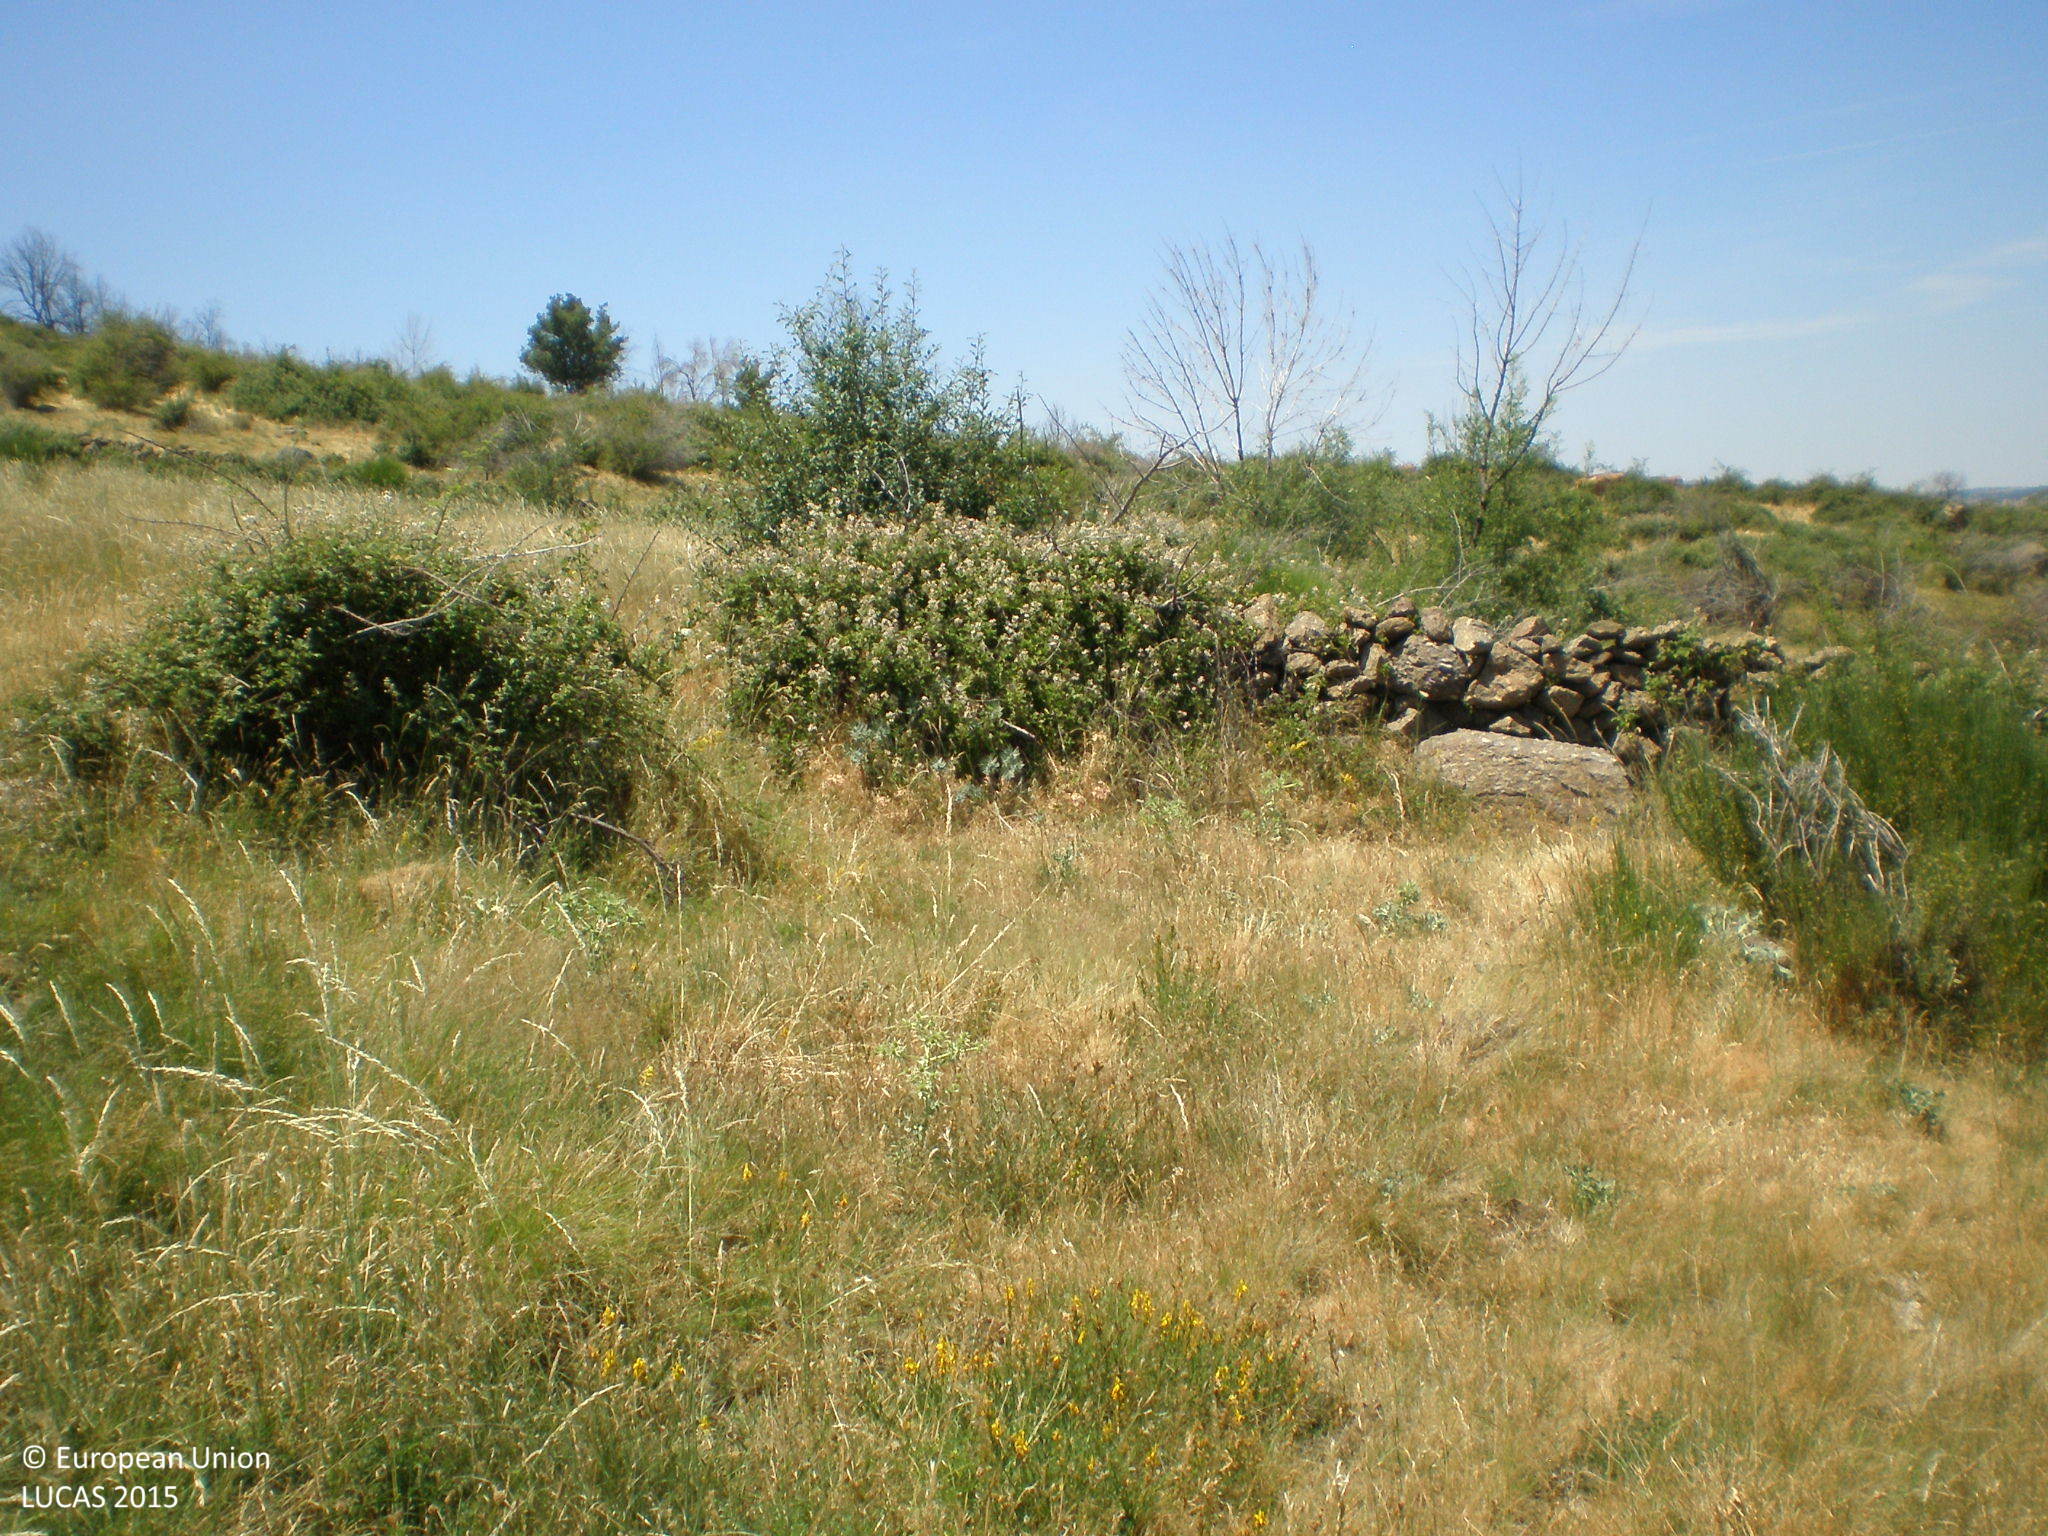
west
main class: Shrubland
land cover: Shrubland without tree cover
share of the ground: 50 - 75 %
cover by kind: shrubs 70 %, herbaceous plants 30 %
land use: Semi-natural and natural areas not in use
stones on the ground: < 10 %
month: June
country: ES
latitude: 40.3924
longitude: -5.5828
